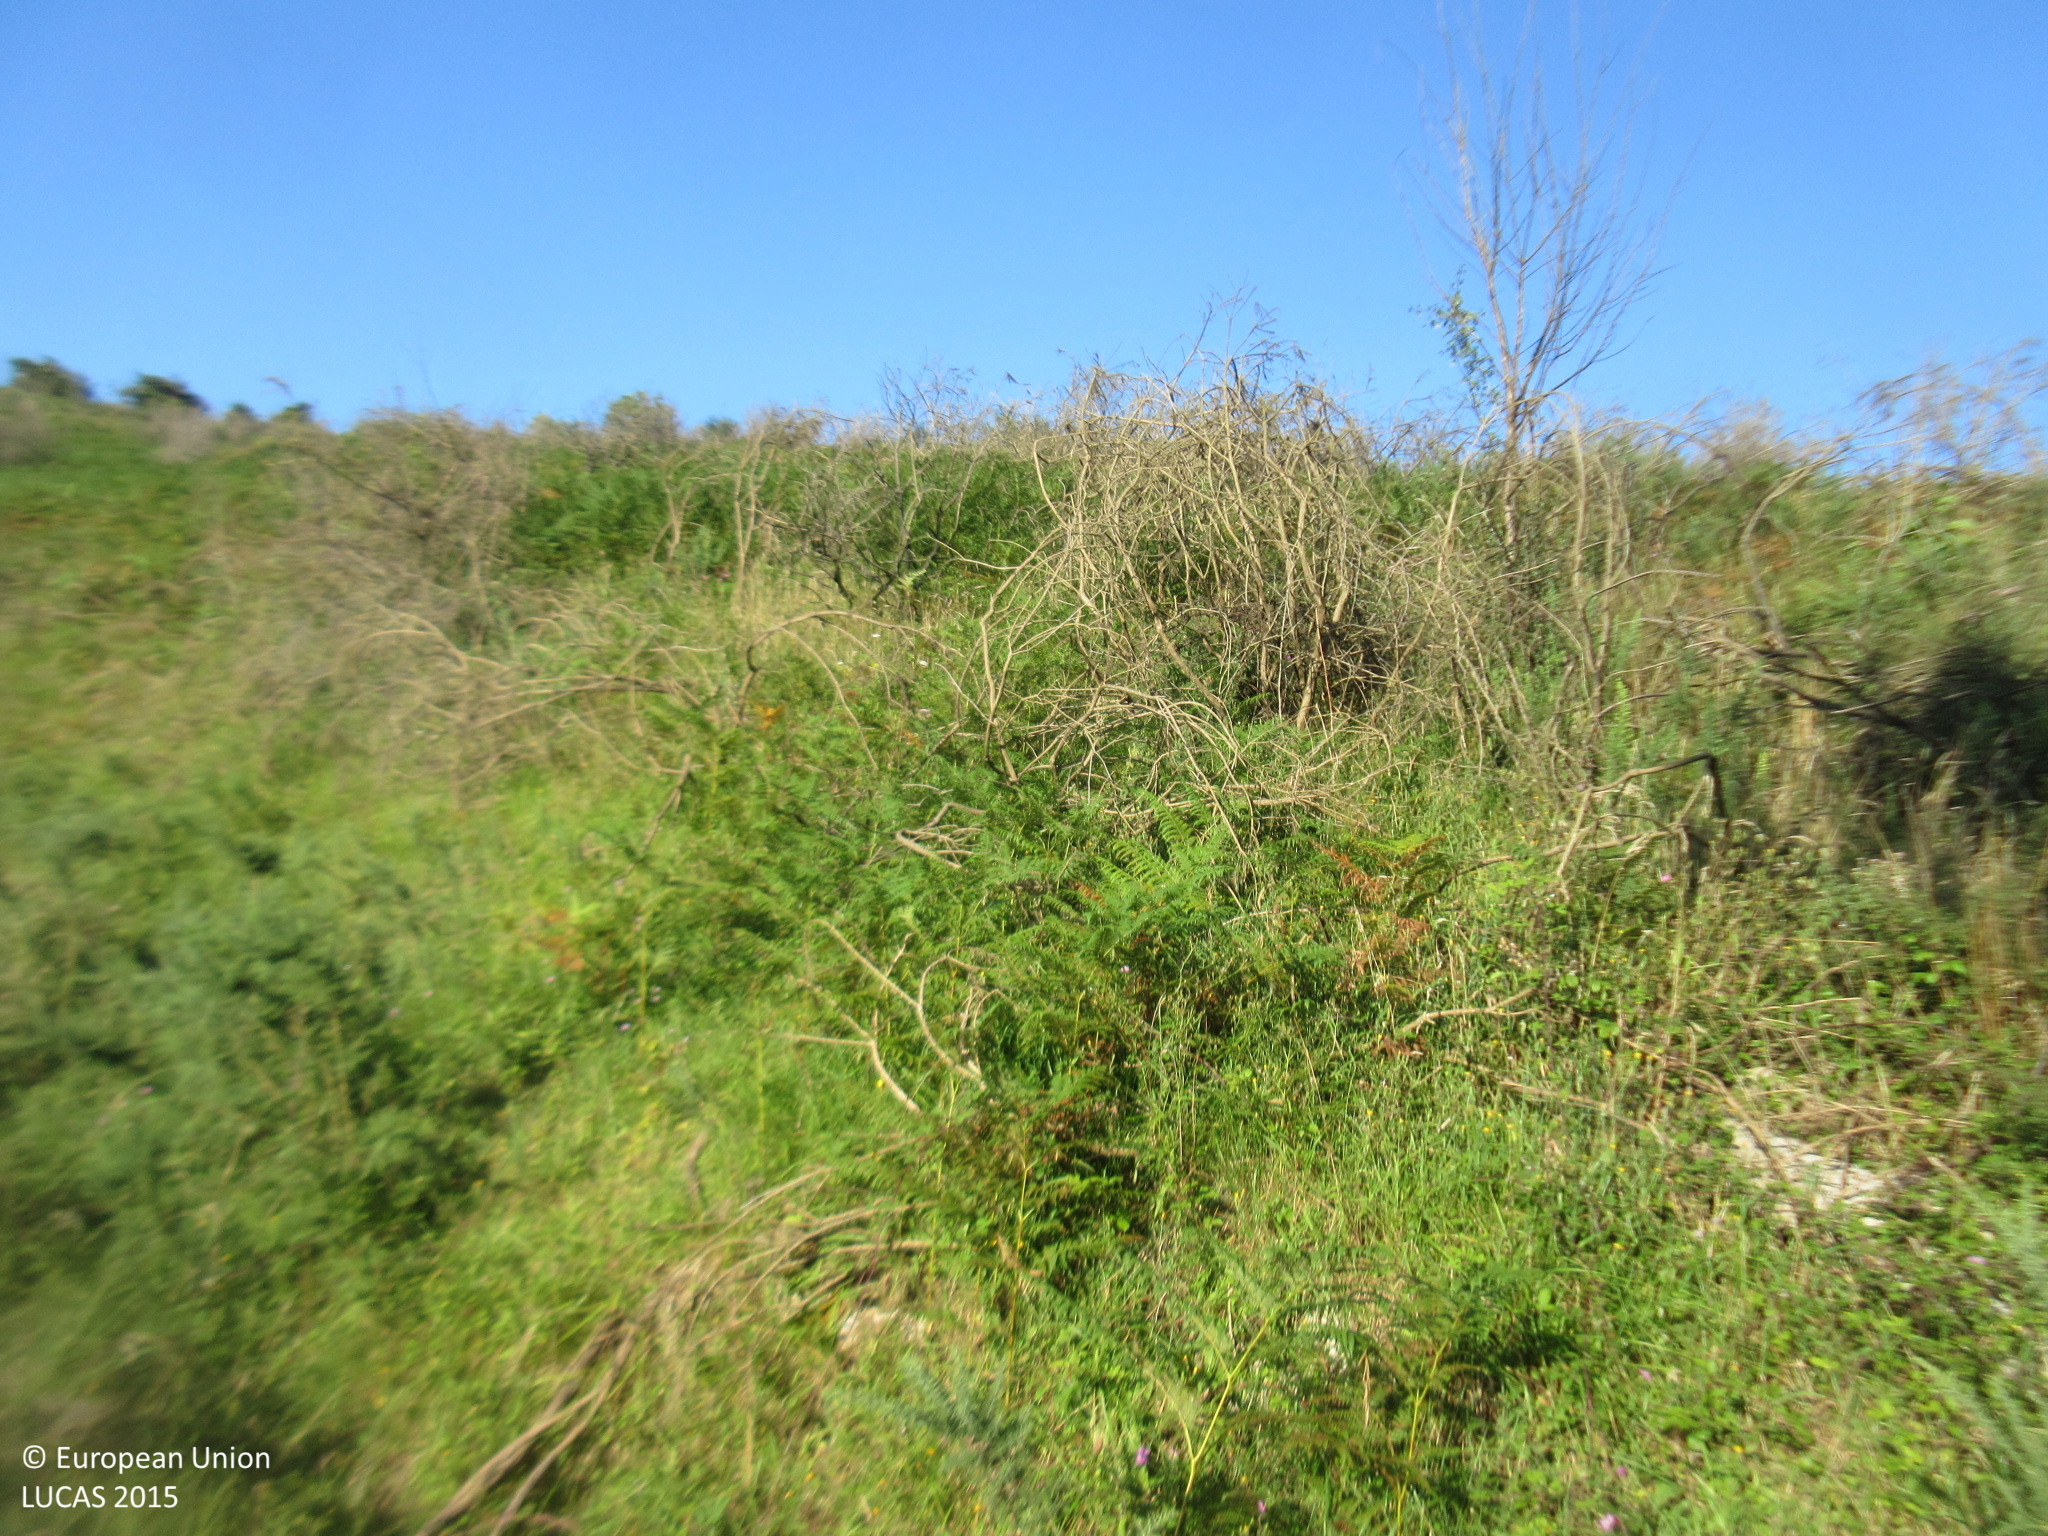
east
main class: Woodland
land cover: Pine dominated coniferous woodland
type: hemiboreal forest and nemoral coniferous forest and mixed broadleaved-coniferous forest
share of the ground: > 75 %
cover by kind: coniferous forest trees 95 %, shrubs 5 %
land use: Forestry
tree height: > 5 m
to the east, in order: Pine dominated coniferous woodland; Tracks; Shrubland without tree cover; Grassland without tree/shrub cover; Fences; Grassland without tree/shrub cover; Pine dominated coniferous woodland
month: July
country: ES
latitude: 43.2237
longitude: -3.9238
